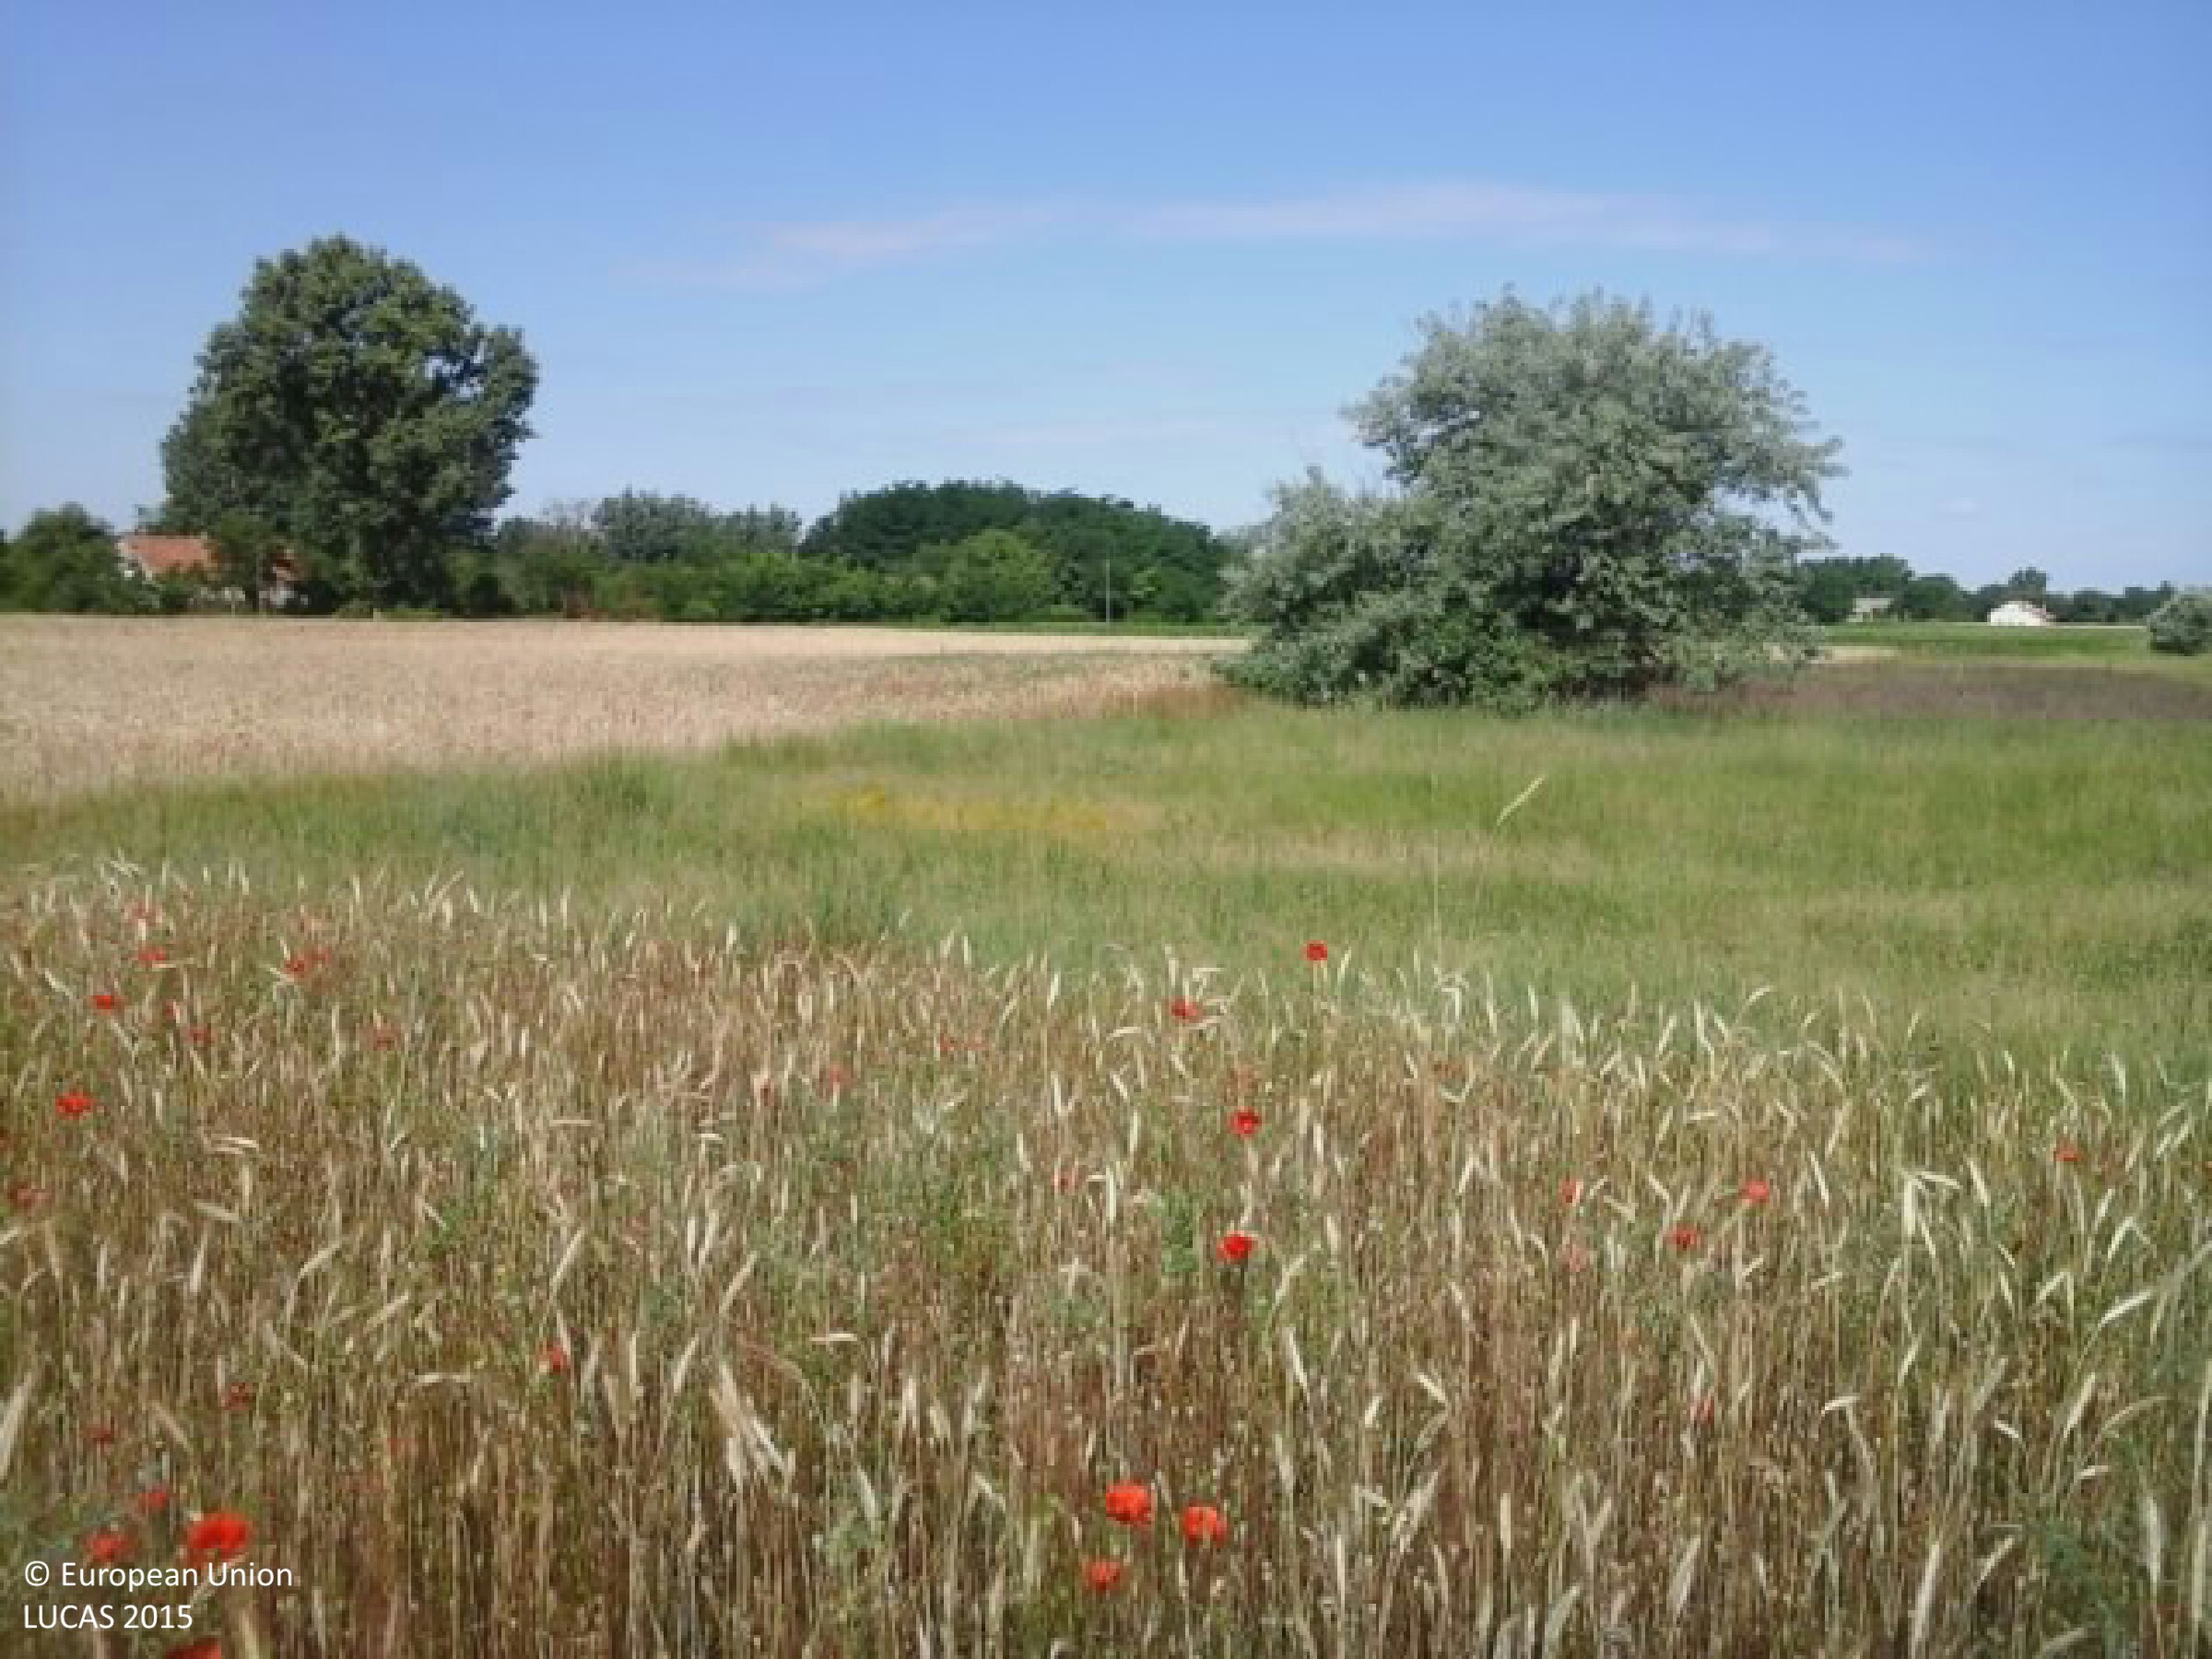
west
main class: Cropland
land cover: Common wheat
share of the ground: > 75 %
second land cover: Spontaneously vegetated surfaces
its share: 10 - 25 %
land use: Agriculture (excluding fallow land and kitchen gardens)
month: June
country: HU
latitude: 46.8807
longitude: 19.5857
